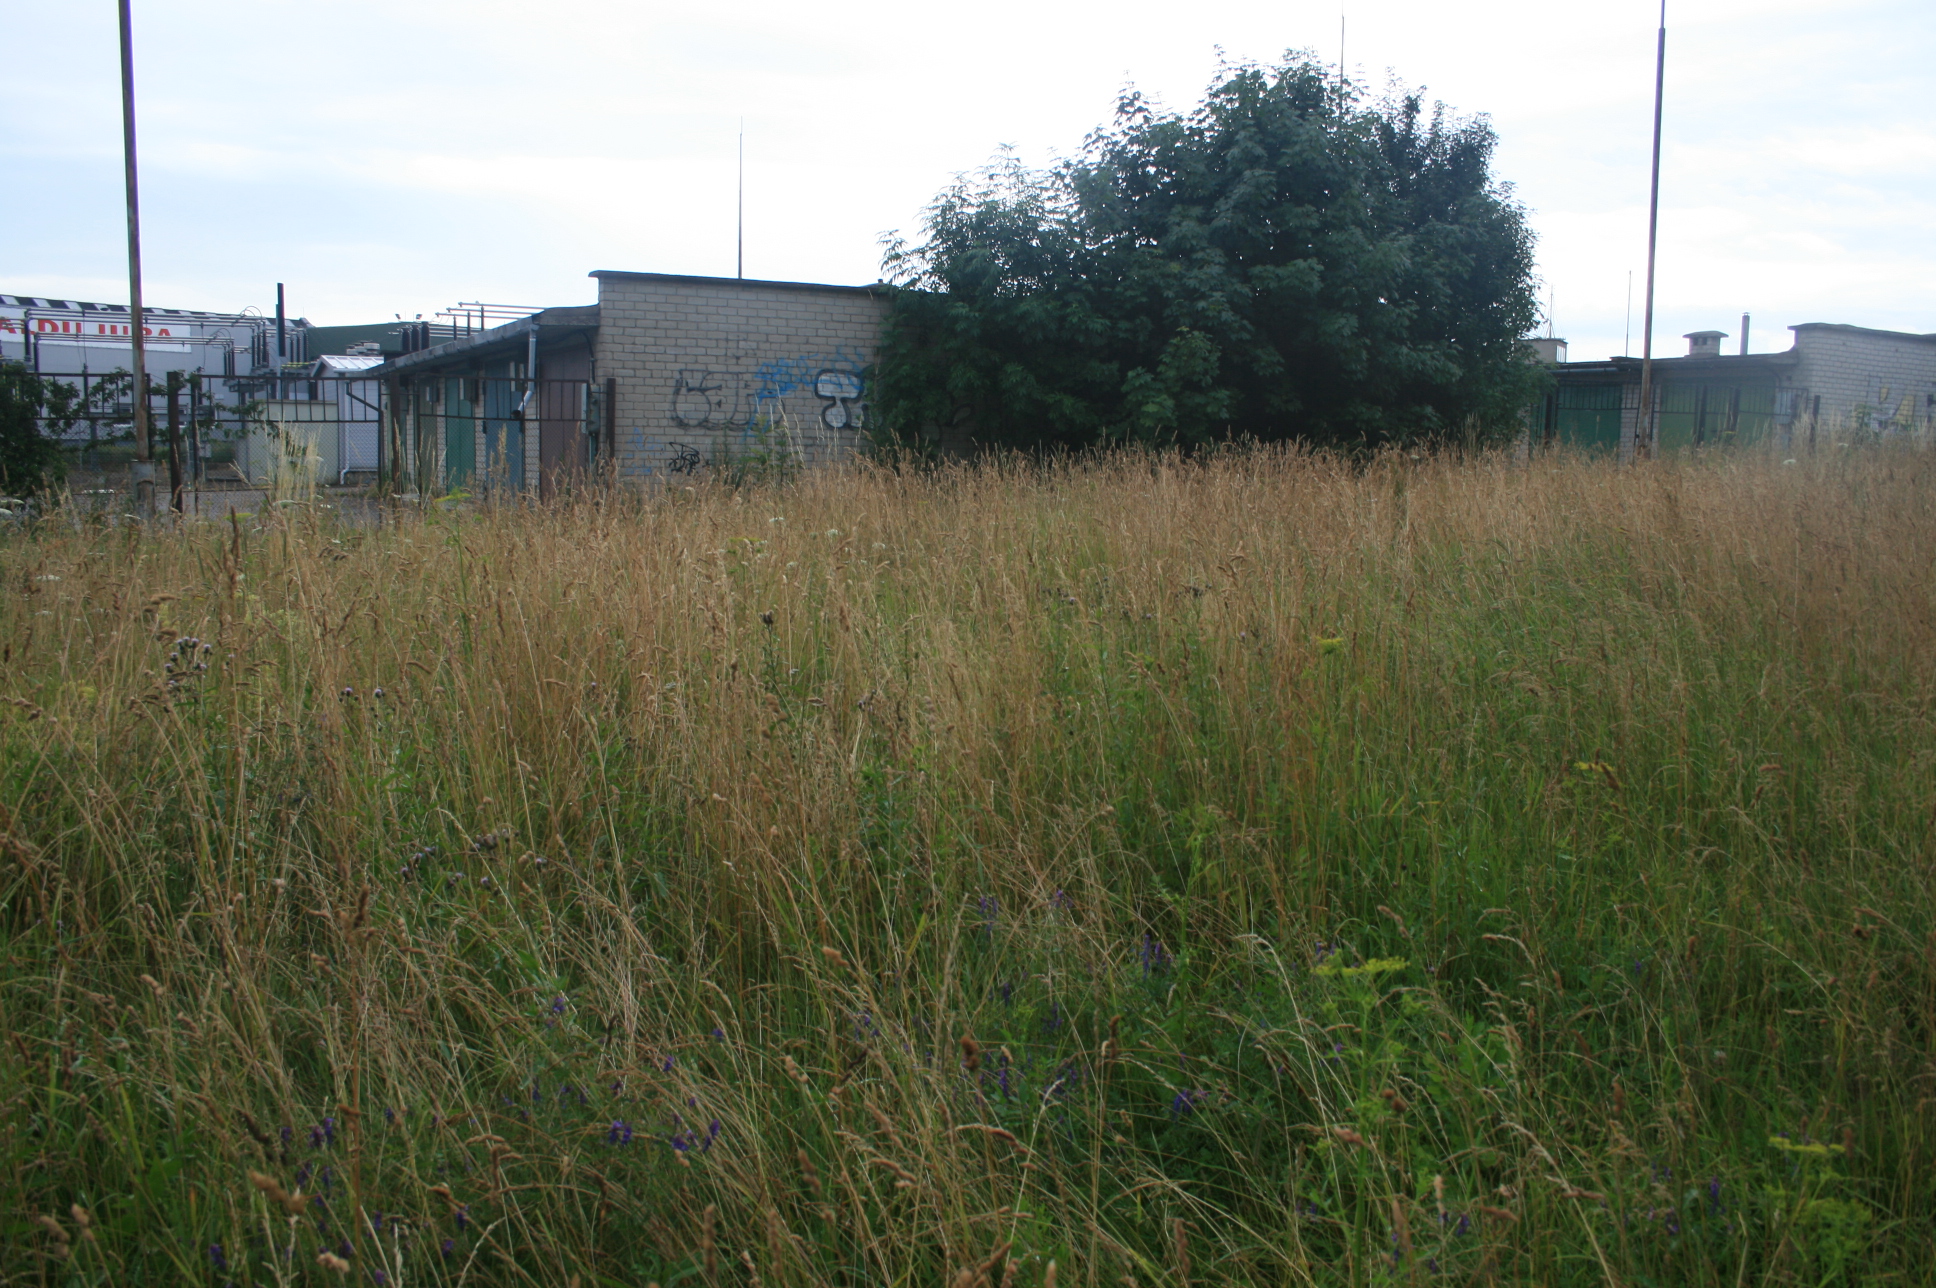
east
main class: Grassland
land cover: Grassland without tree/shrub cover
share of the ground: > 75 %
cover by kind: herbaceous plants 100 %
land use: Residential
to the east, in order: Grassland without tree/shrub cover; Artificial constructions in urban areas
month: July
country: LT
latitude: 55.6786
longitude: 21.1889
